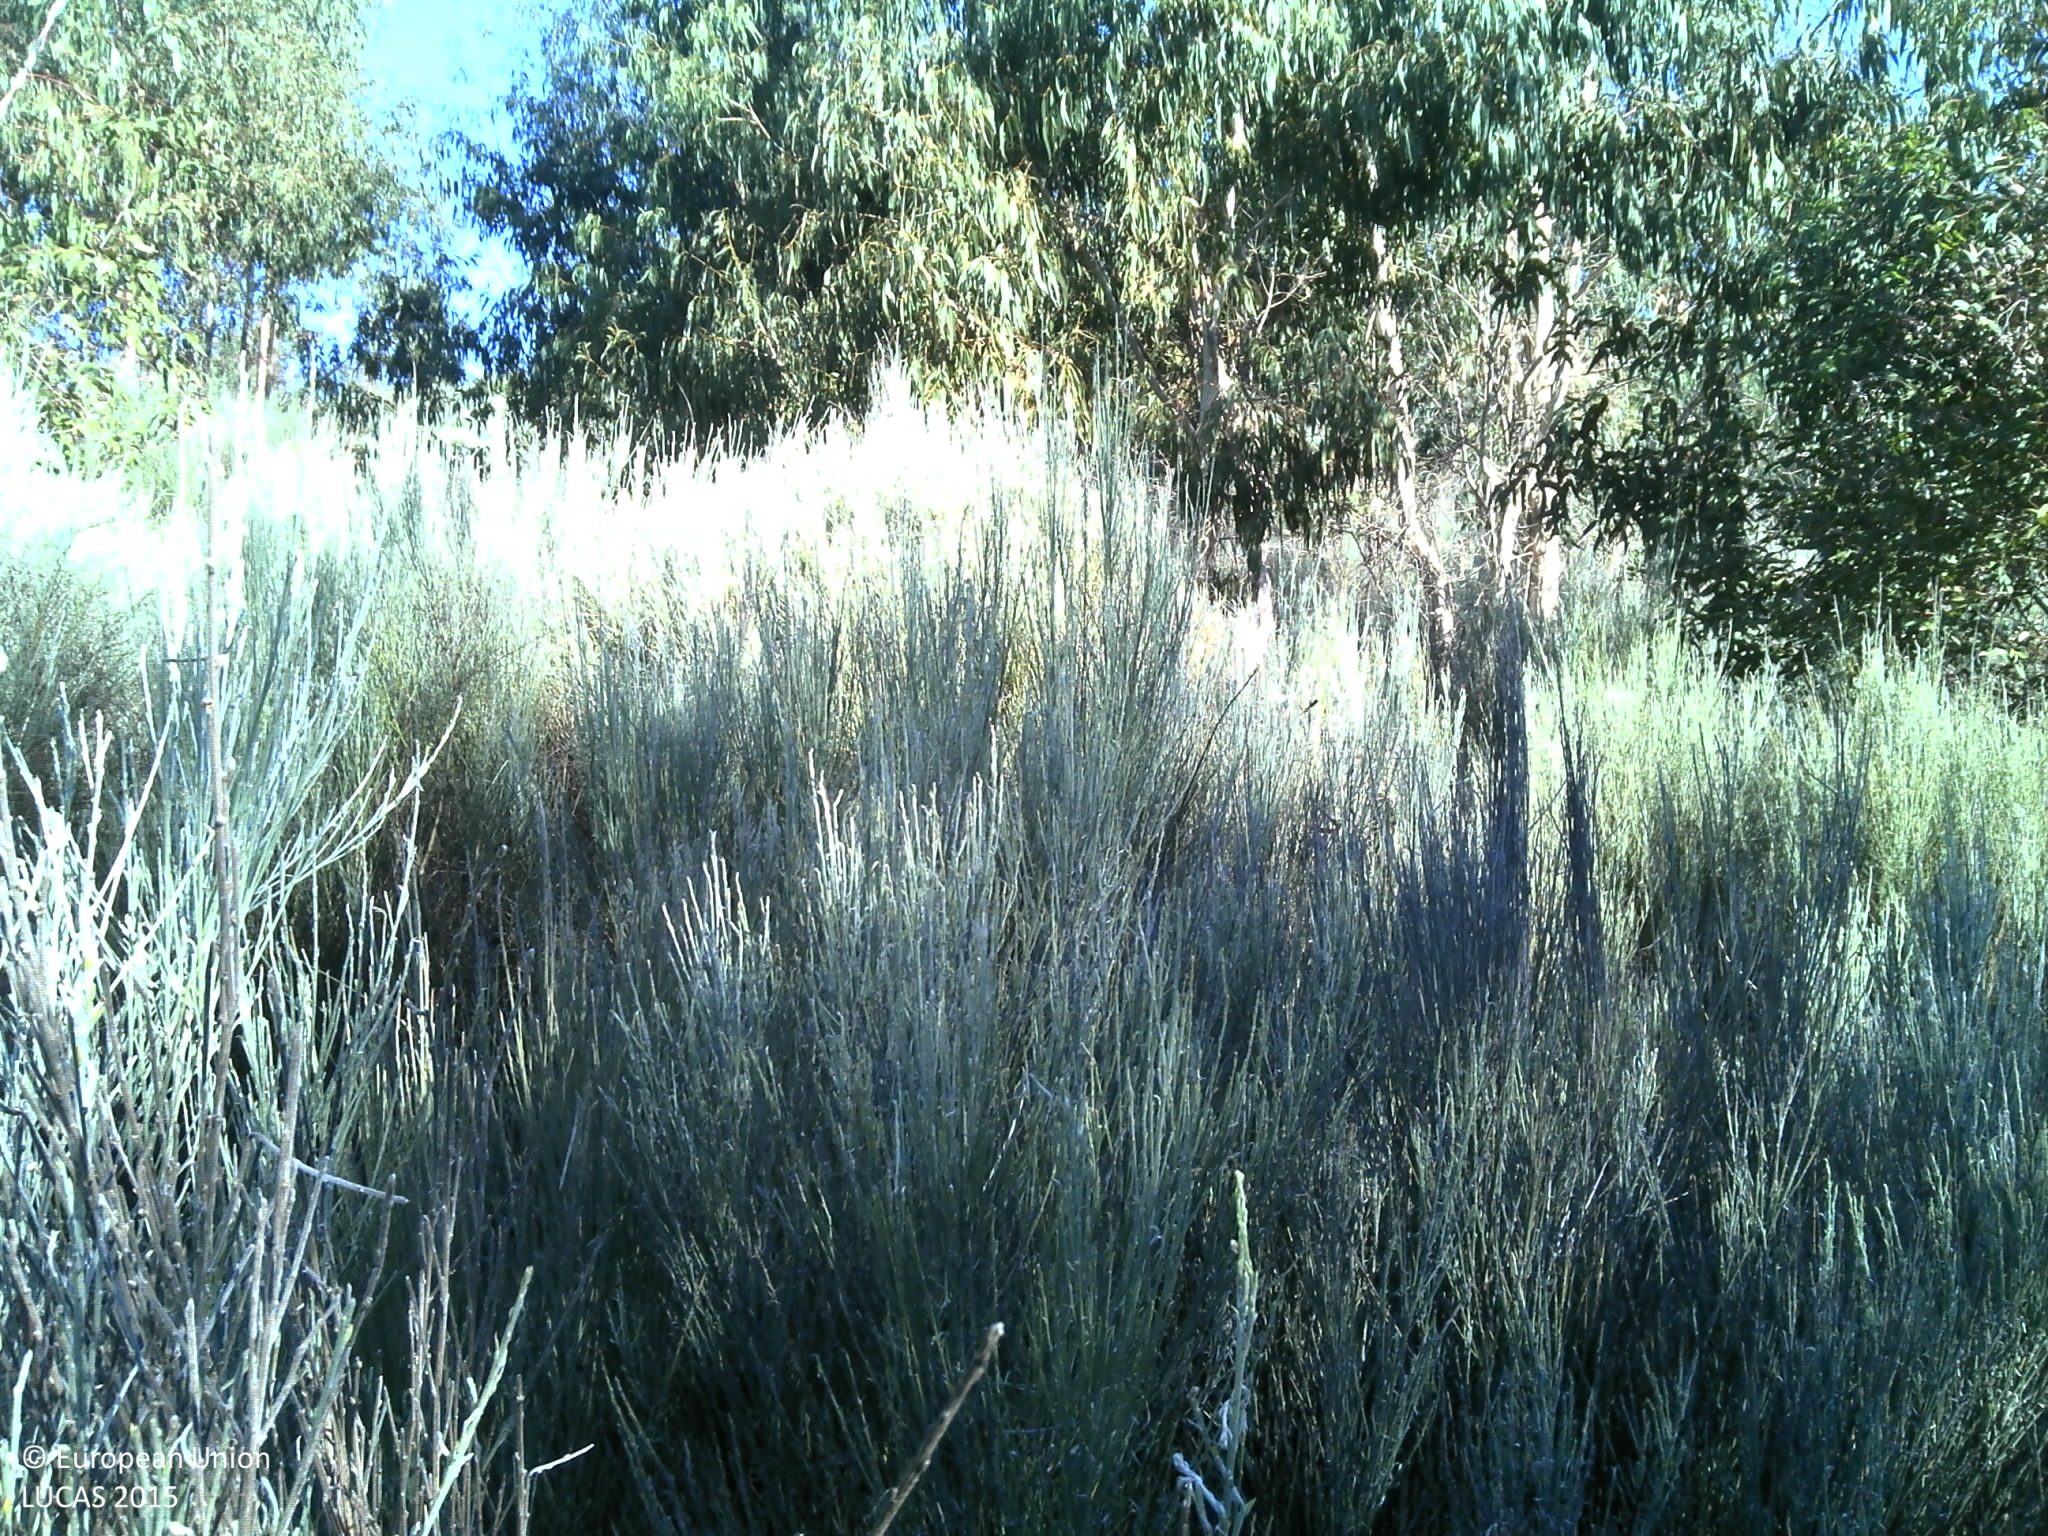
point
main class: Woodland
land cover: Broadleaved woodland
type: exotic forest
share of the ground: 25 - 50 %
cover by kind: broadleaved forest trees 50 %, shrubs 40 %, unconsolidated bare surface 10 %
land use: Forestry
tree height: > 5 m
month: June
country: PT
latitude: 40.8381
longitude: -7.1986
